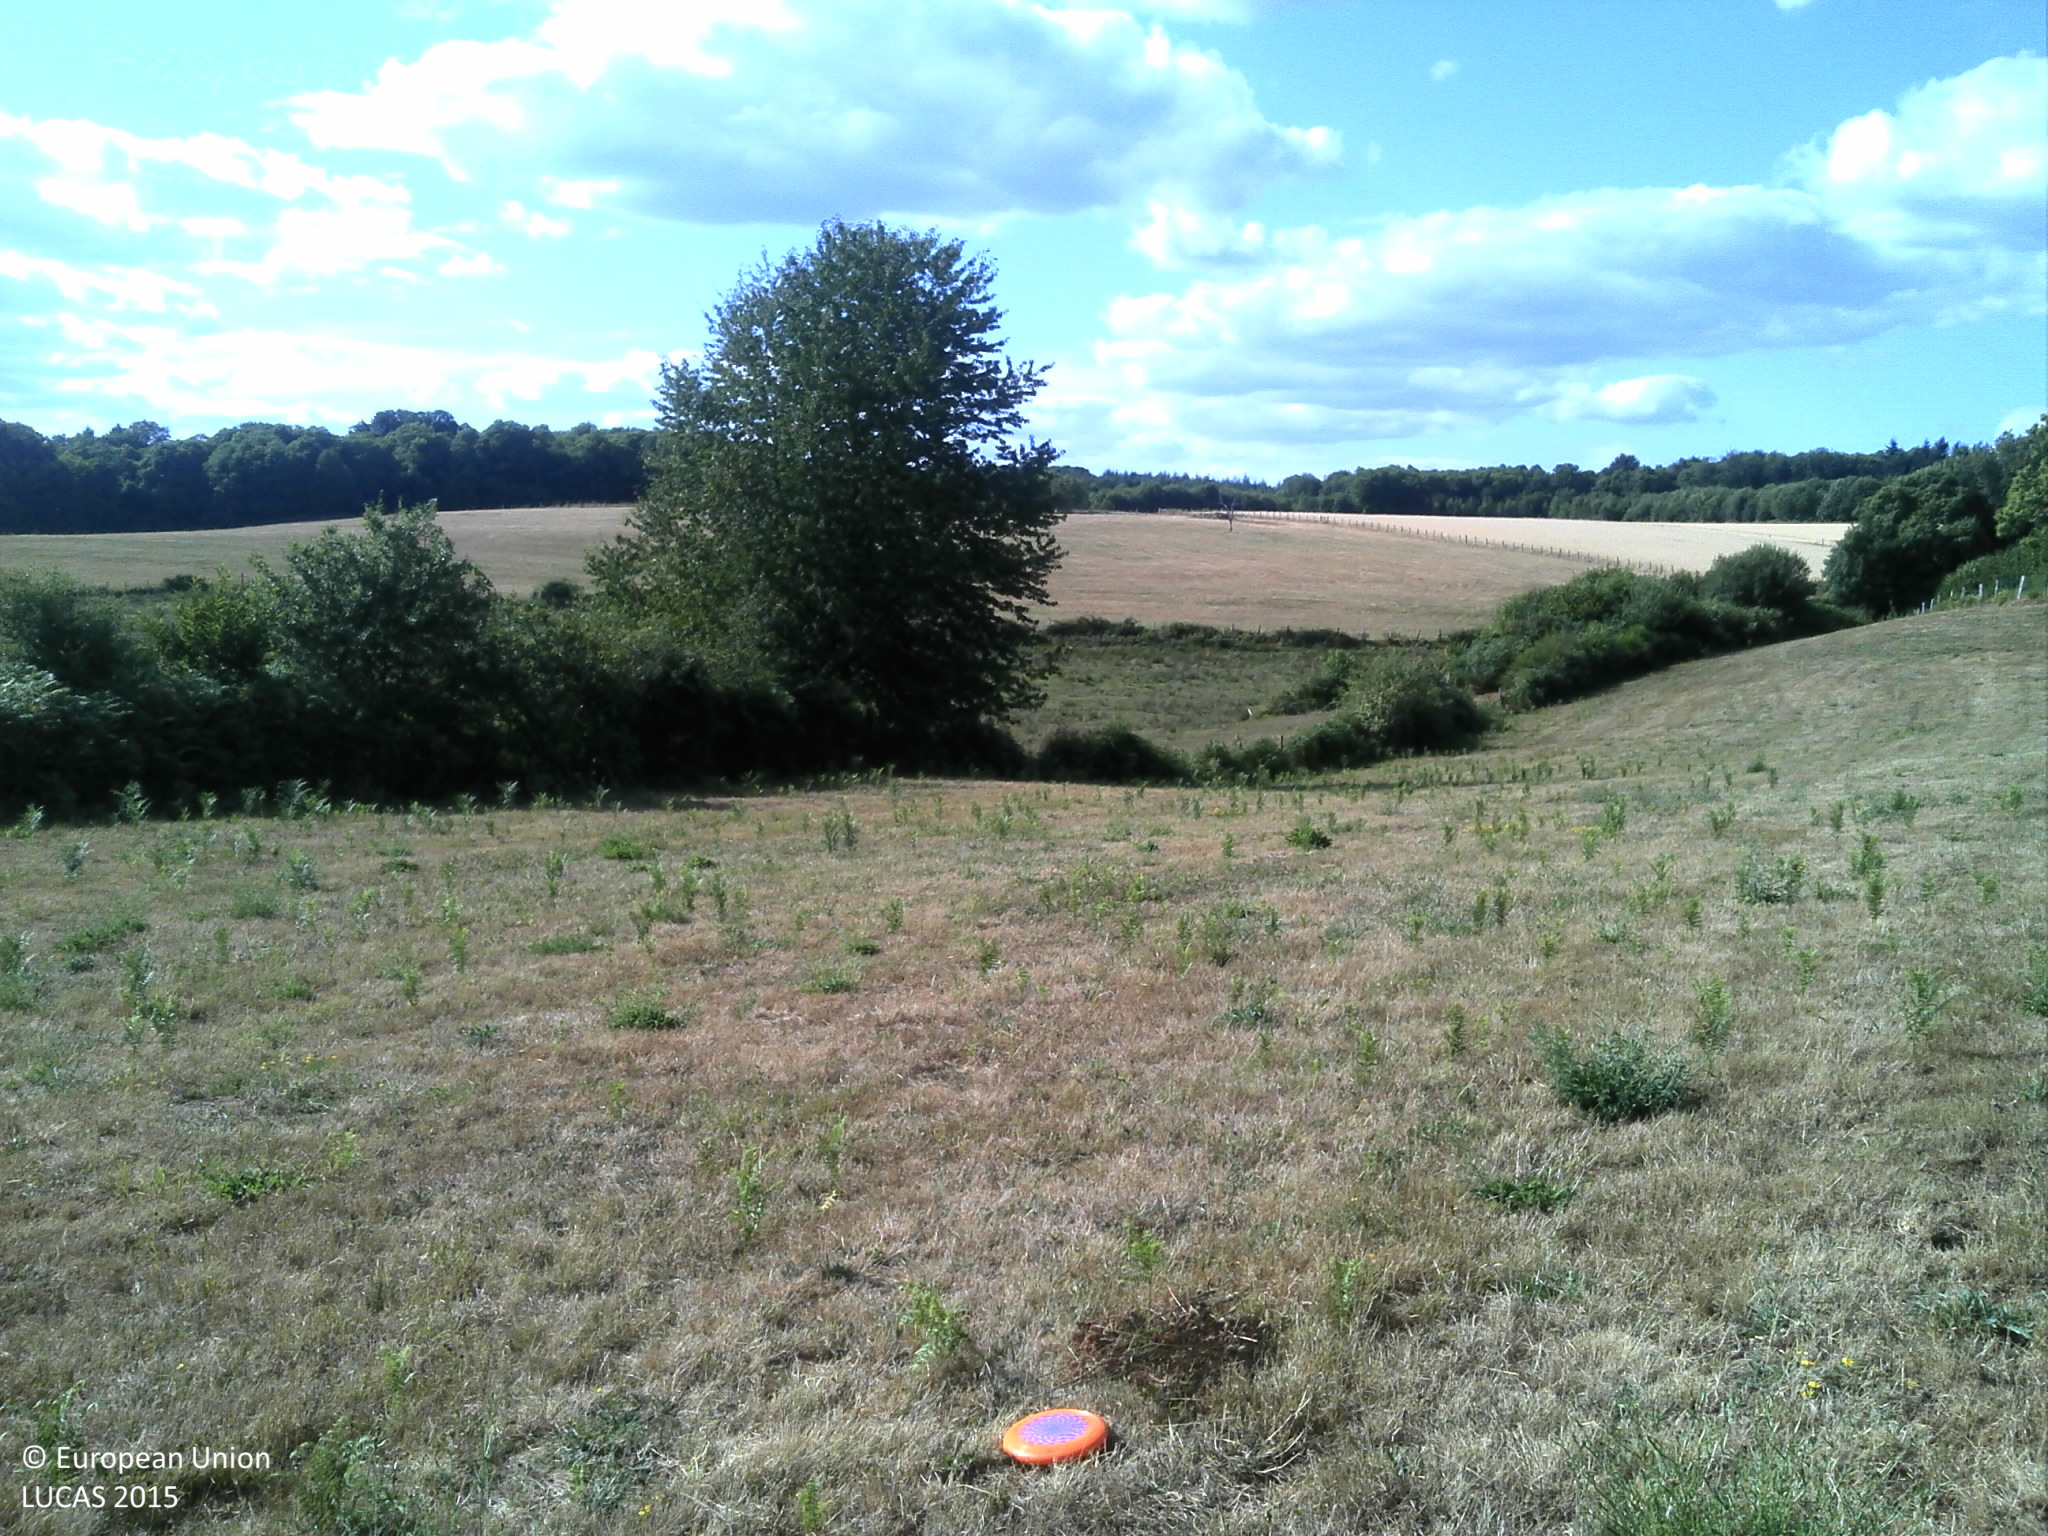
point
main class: Grassland
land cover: Grassland without tree/shrub cover
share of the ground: > 75 %
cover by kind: herbaceous plants 100 %
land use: Agriculture (excluding fallow land and kitchen gardens)
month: July
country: FR
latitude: 45.1801
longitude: 1.7372
